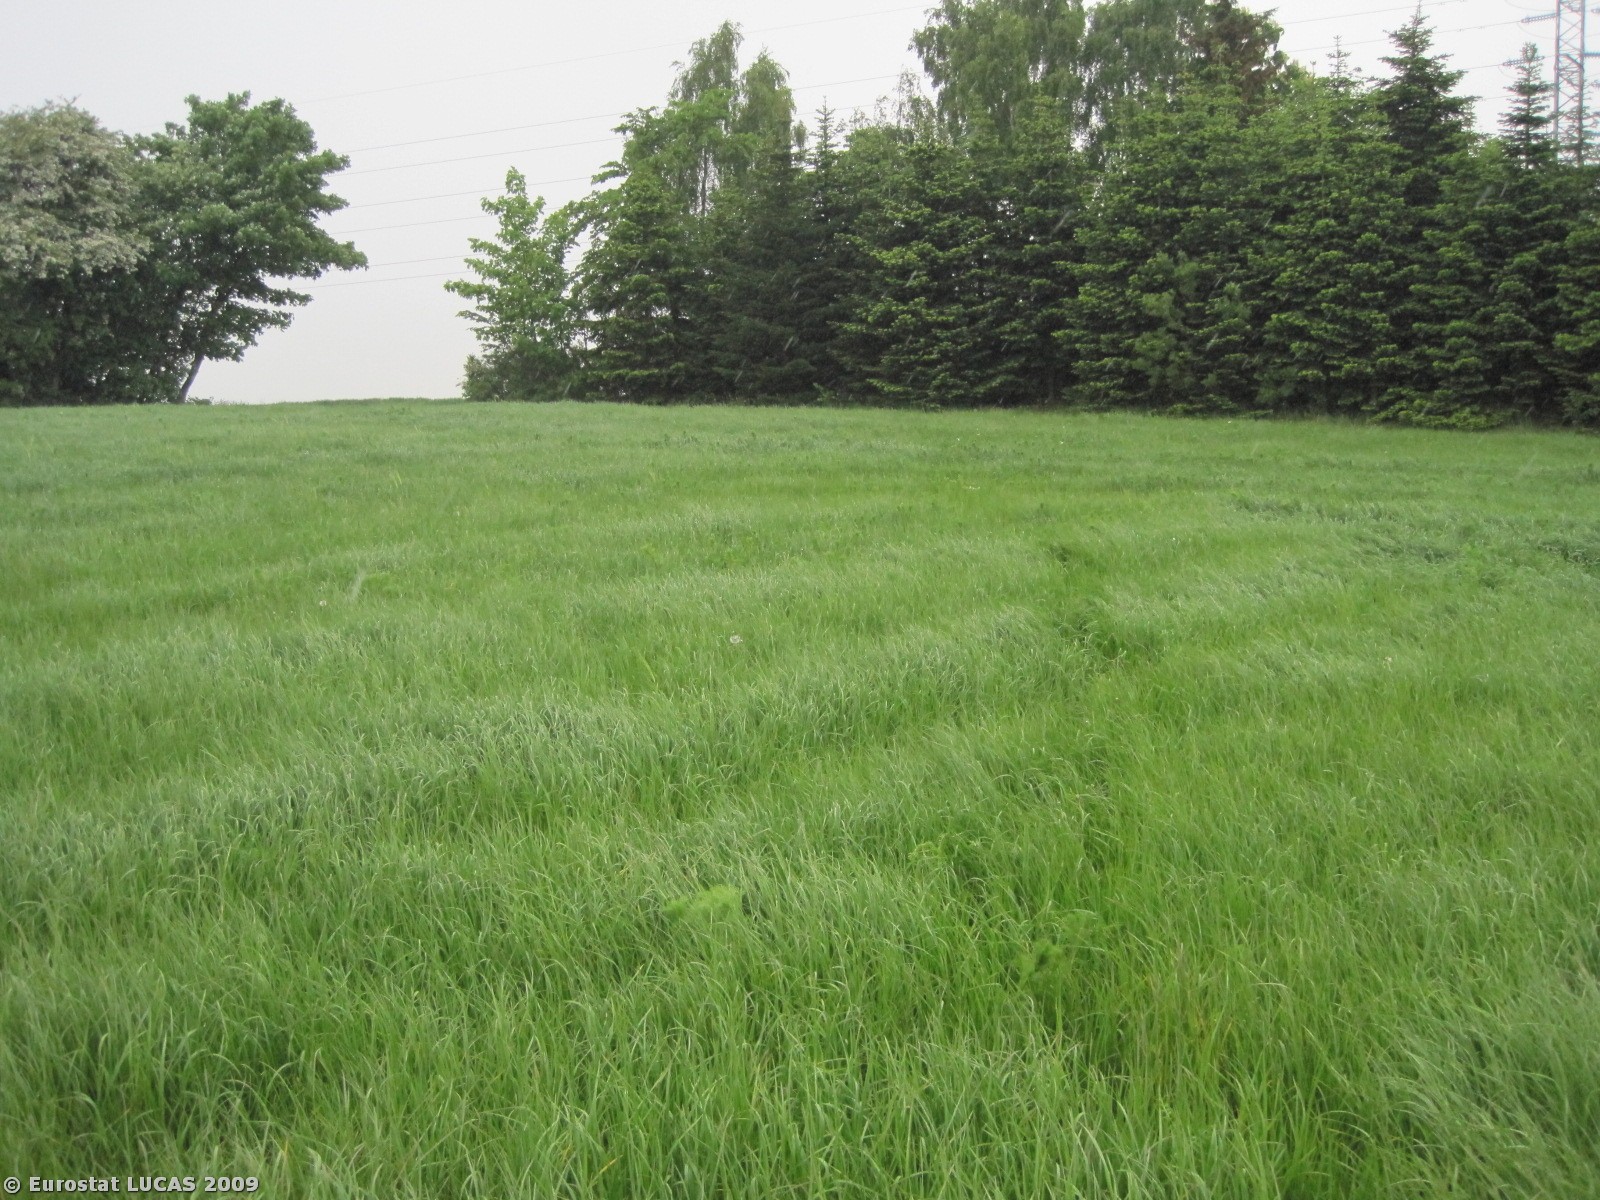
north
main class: Grassland
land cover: Grassland without tree/shrub cover
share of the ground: > 75 %
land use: Agriculture (excluding fallow land and kitchen gardens)
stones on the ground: < 10 %
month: May
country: DK
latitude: 56.3315
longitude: 9.8546
